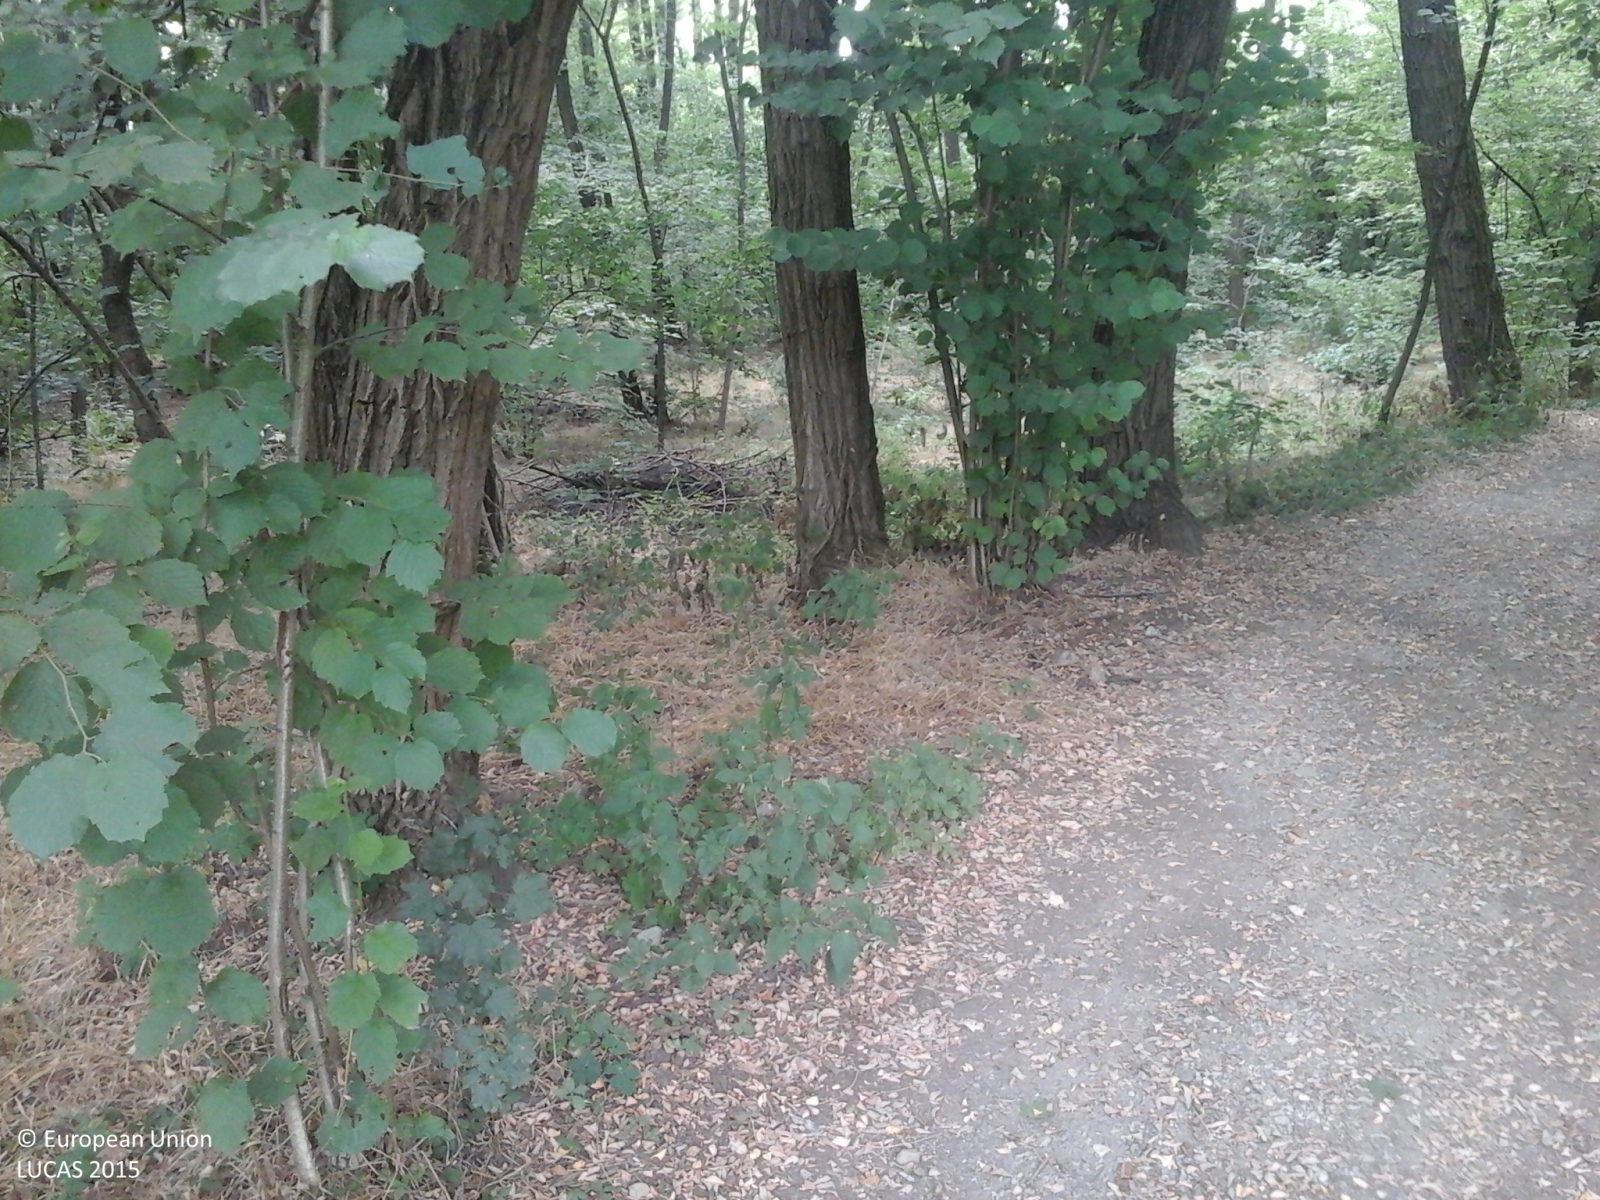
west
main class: Woodland
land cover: Broadleaved woodland
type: thermophilous deciduous forest
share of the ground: 50 - 75 %
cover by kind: broadleaved forest trees 70 %, herbaceous plants 25 %, coniferous forest trees 5 %
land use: Forestry
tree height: > 5 m
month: July
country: IT
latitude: 45.8056
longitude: 8.9593
